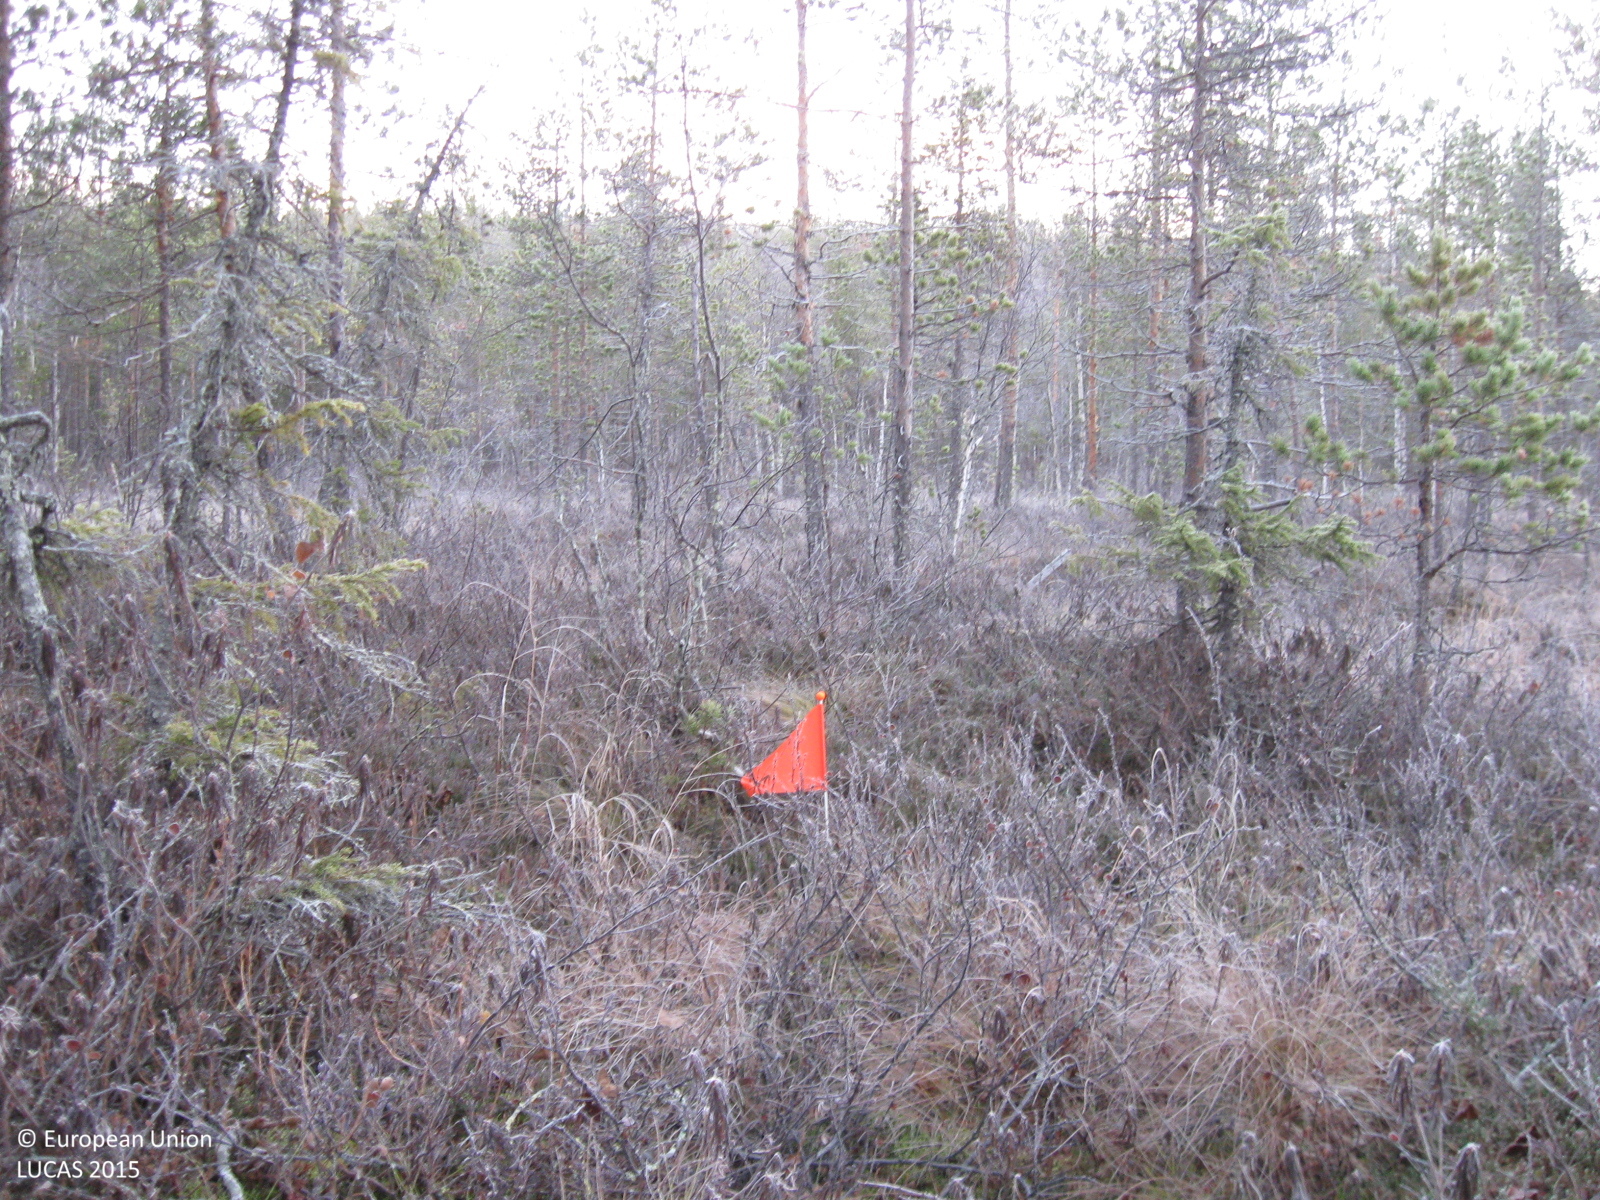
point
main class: Woodland
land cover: Pine dominated coniferous woodland
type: mire and swamp forests
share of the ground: 50 - 75 %
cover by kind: coniferous forest trees 45 %, shrubs 25 %, herbaceous plants 15 %, broadleaved forest trees 10 %, lichens and mosses 5 %
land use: Semi-natural and natural areas not in use
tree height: > 5 m
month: October
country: SE
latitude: 66.1488
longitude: 22.1397
